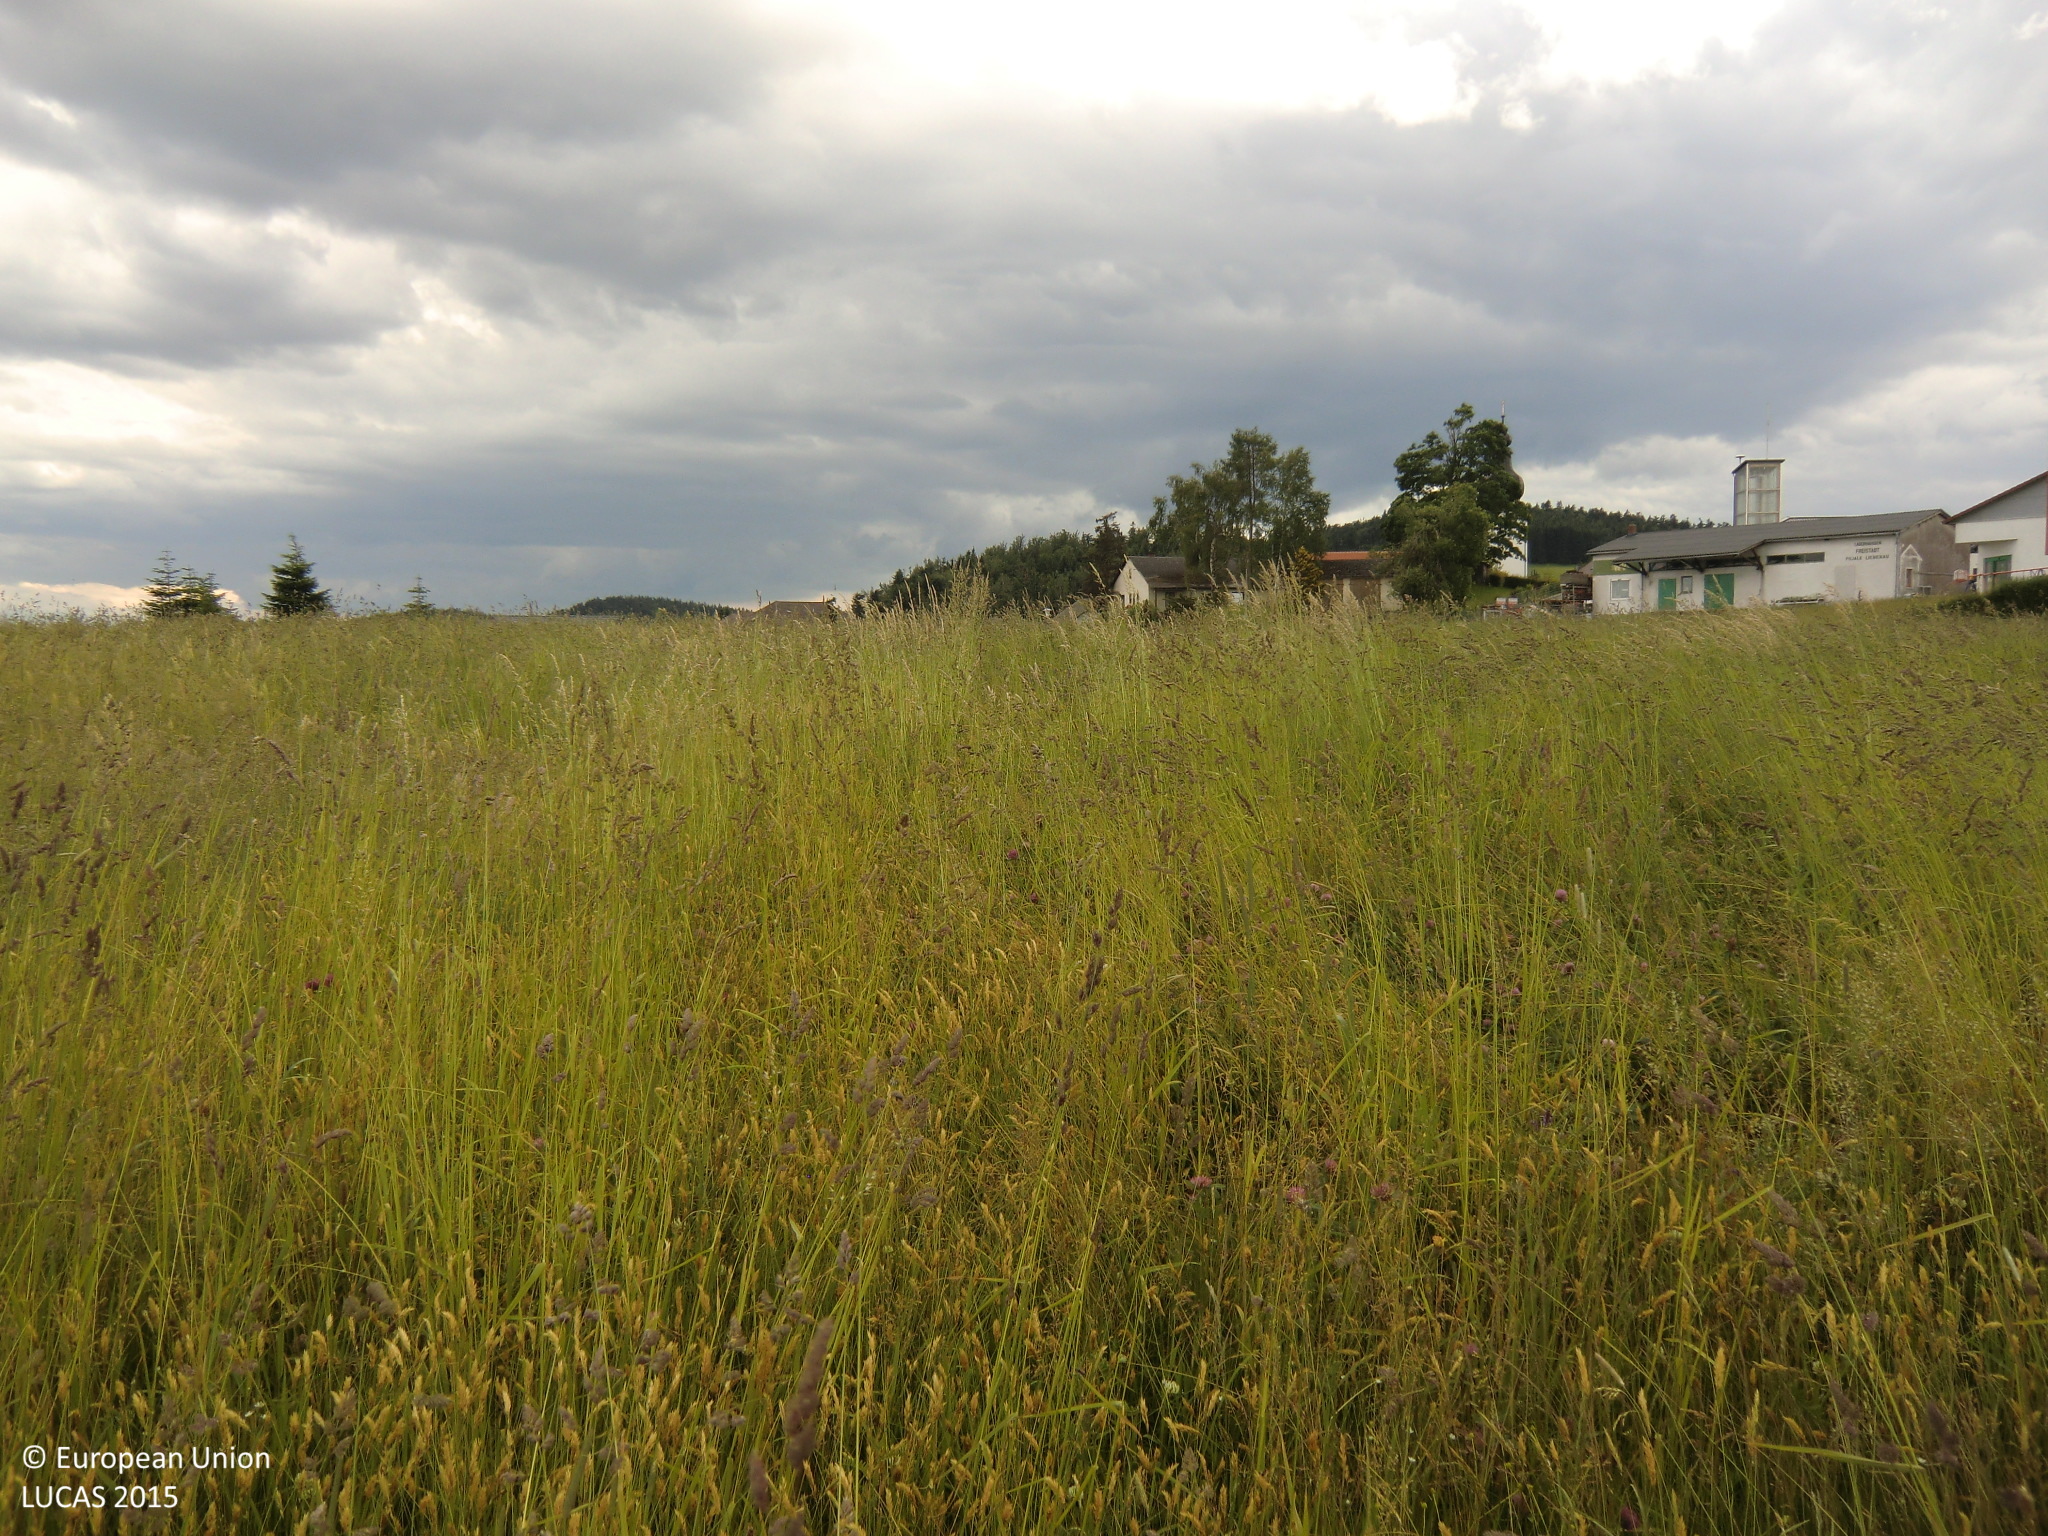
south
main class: Grassland
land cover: Grassland without tree/shrub cover
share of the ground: > 75 %
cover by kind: herbaceous plants 100 %
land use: Agriculture (excluding fallow land and kitchen gardens)
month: June
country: AT
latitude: 48.5332
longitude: 14.8089
